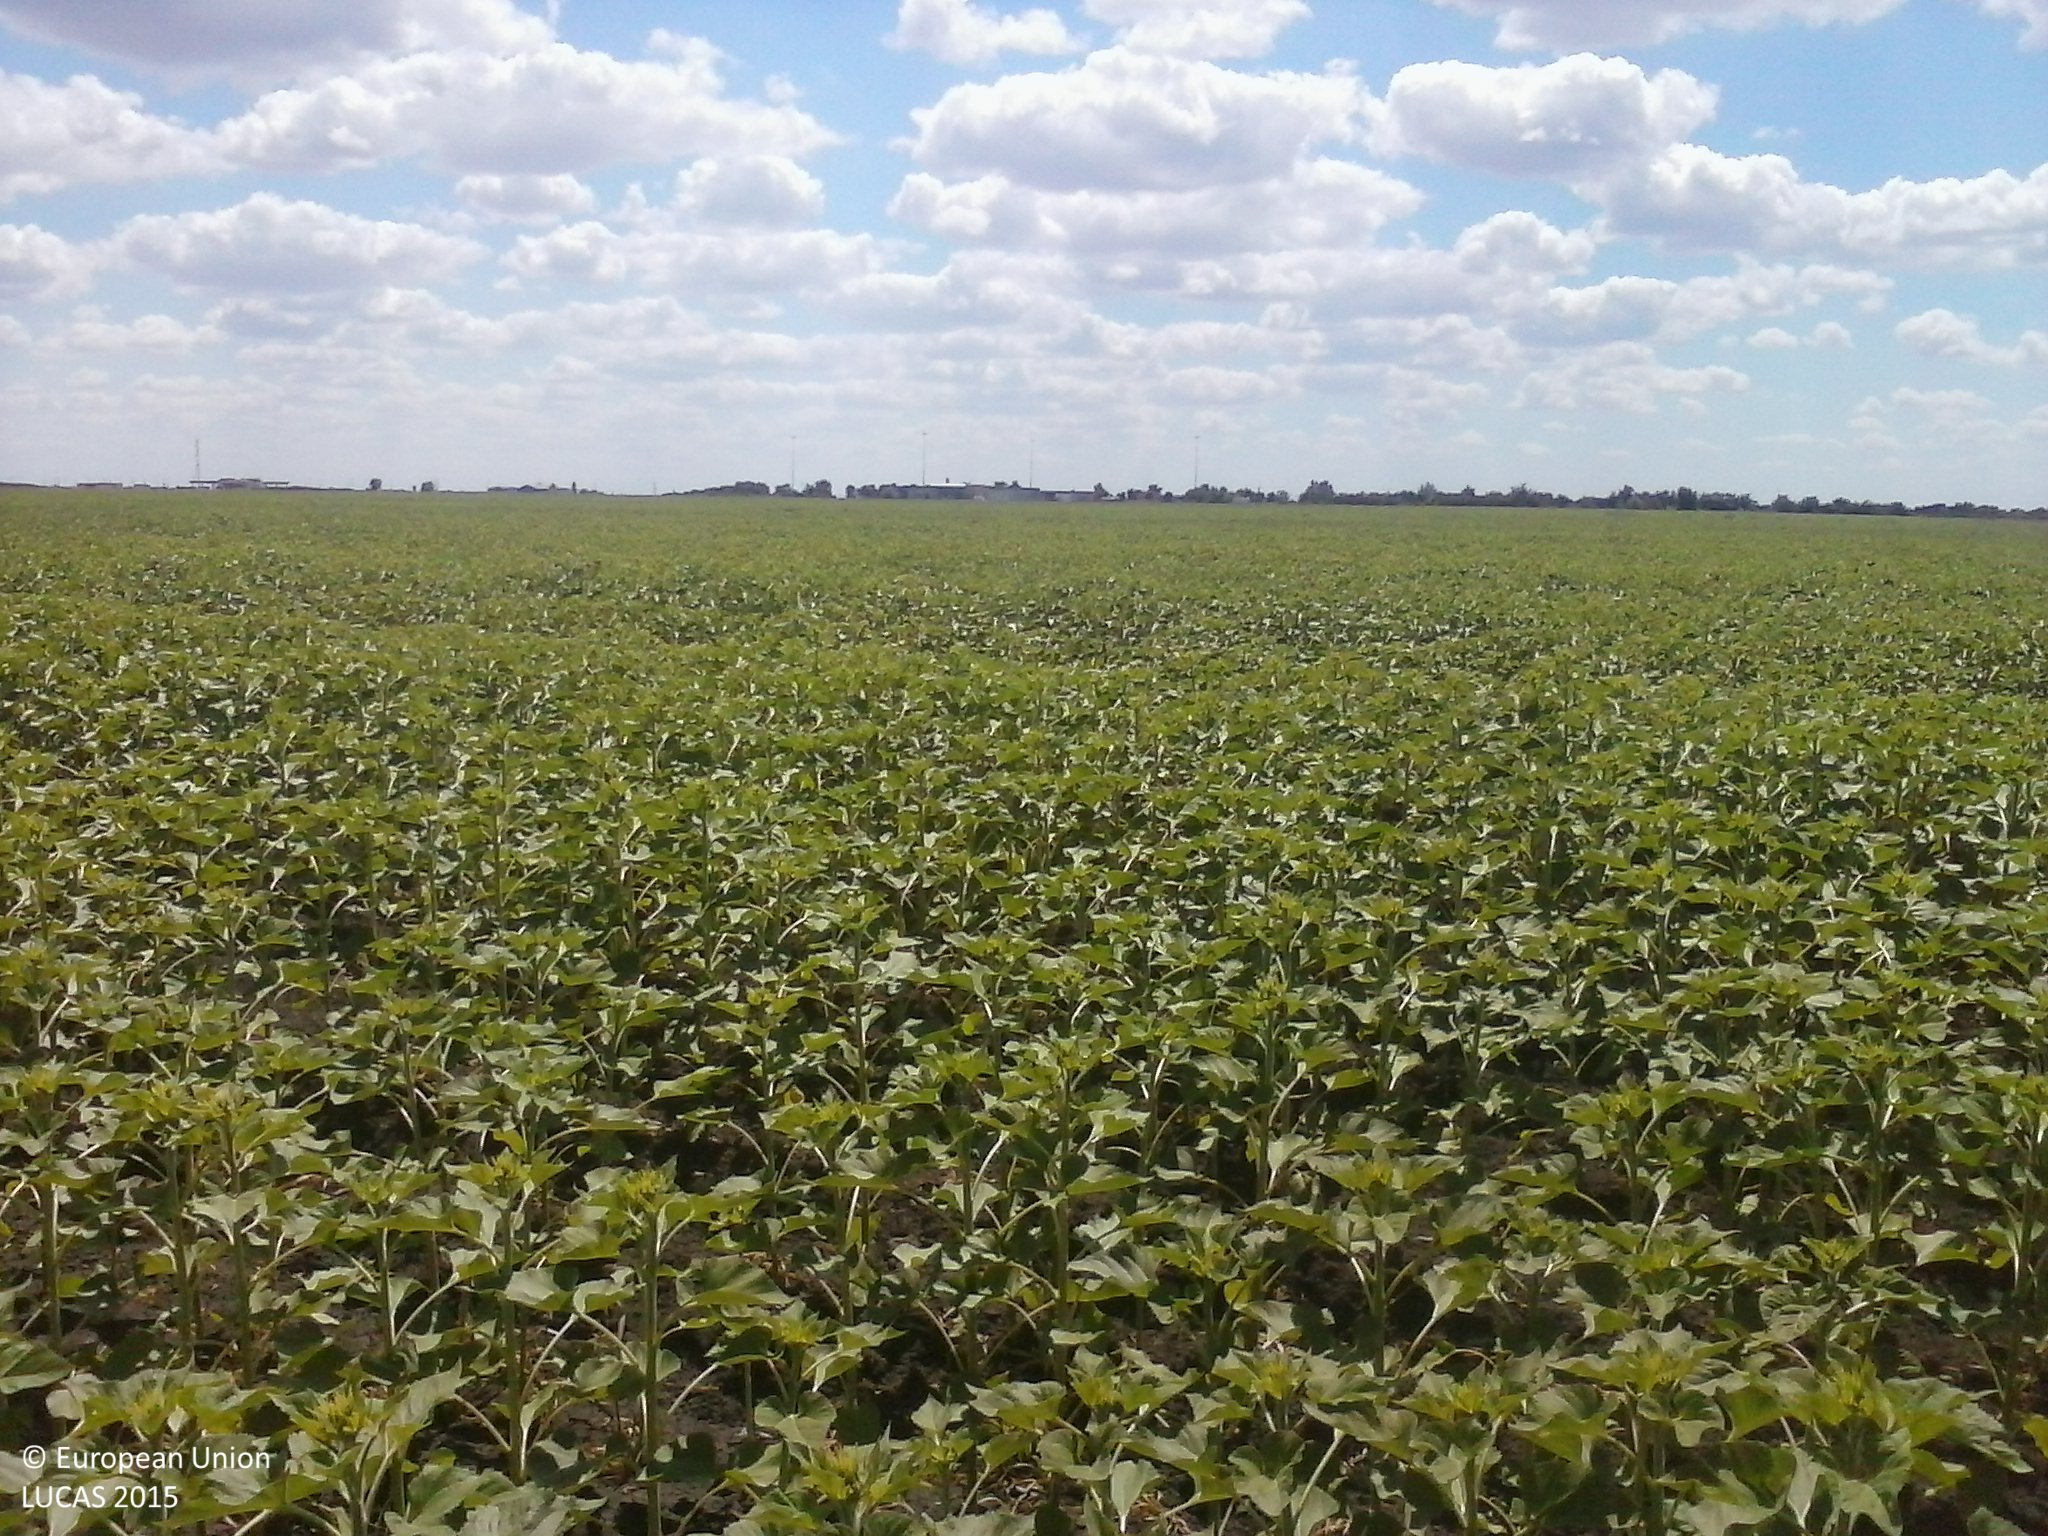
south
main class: Cropland
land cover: Sunflower
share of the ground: > 75 %
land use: Agriculture (excluding fallow land and kitchen gardens)
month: June
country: HU
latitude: 46.1622
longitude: 20.4756
